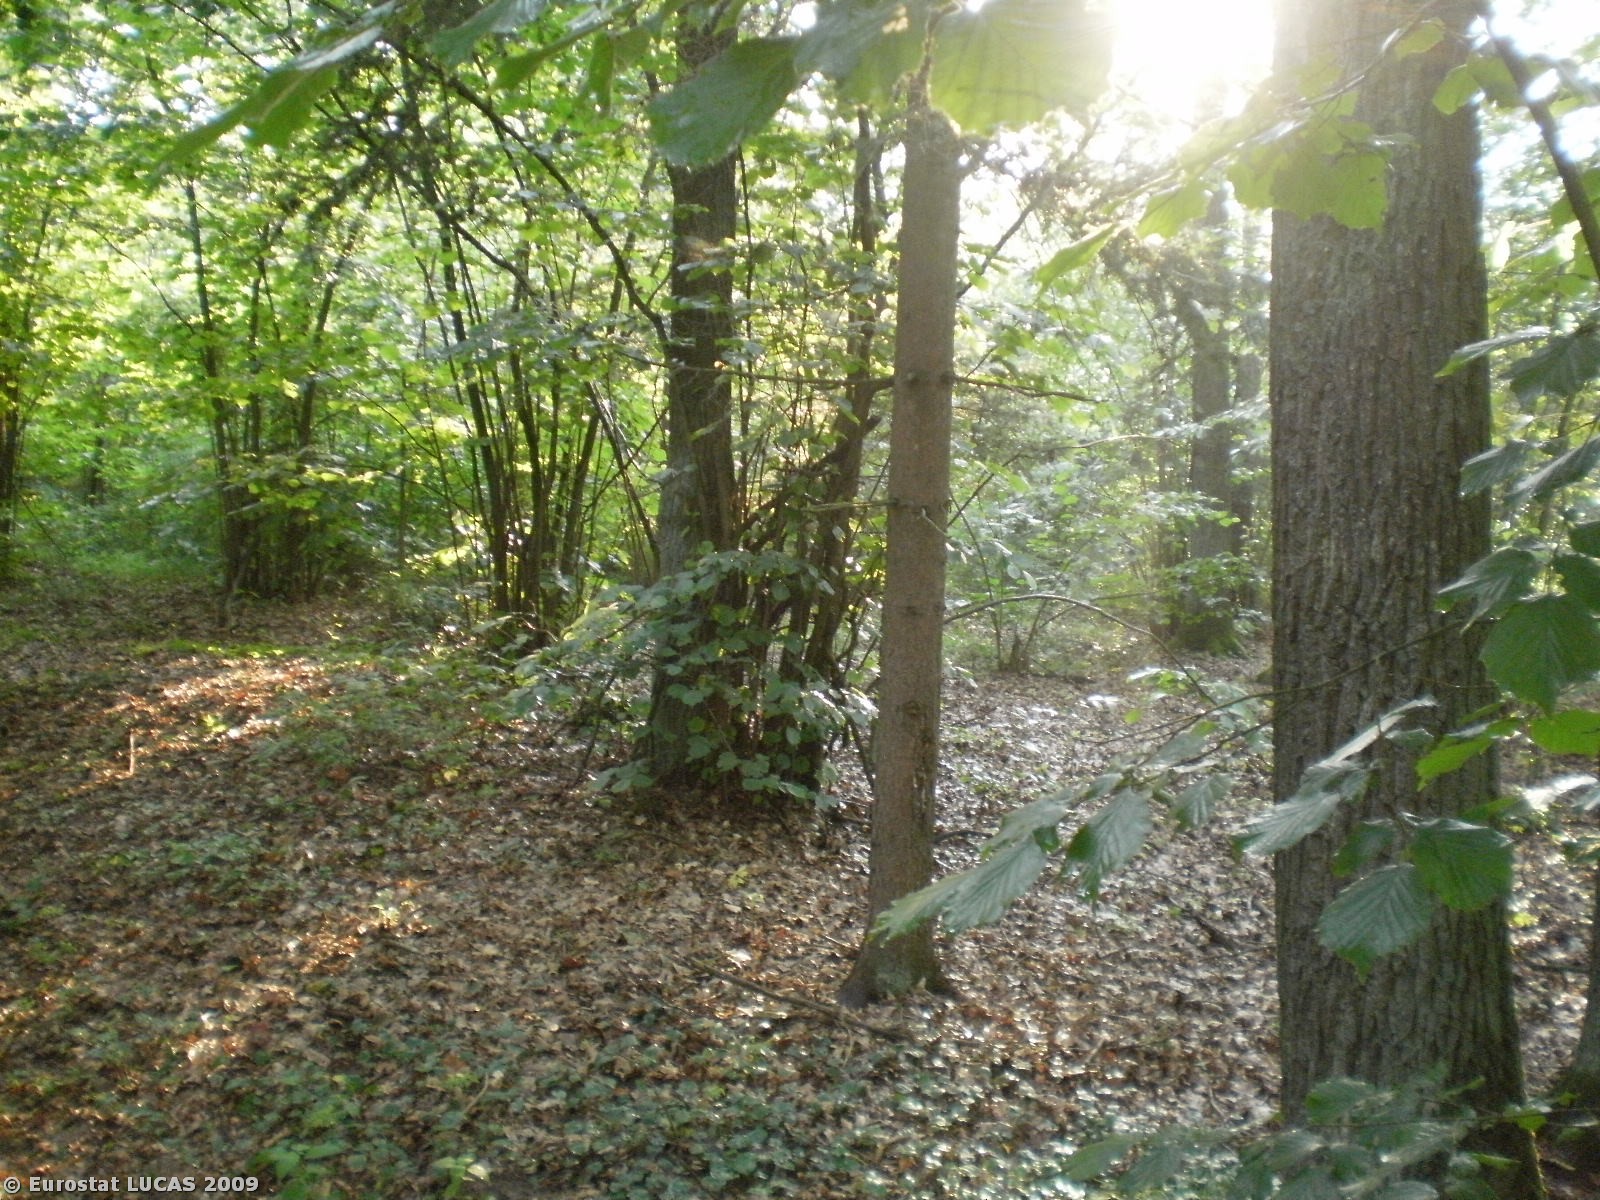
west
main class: Woodland
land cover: Mixed woodland
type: mesophytic deciduous forest
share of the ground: > 75 %
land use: Forestry
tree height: > 5 m
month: July
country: PL
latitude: 52.7750
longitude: 20.9686
